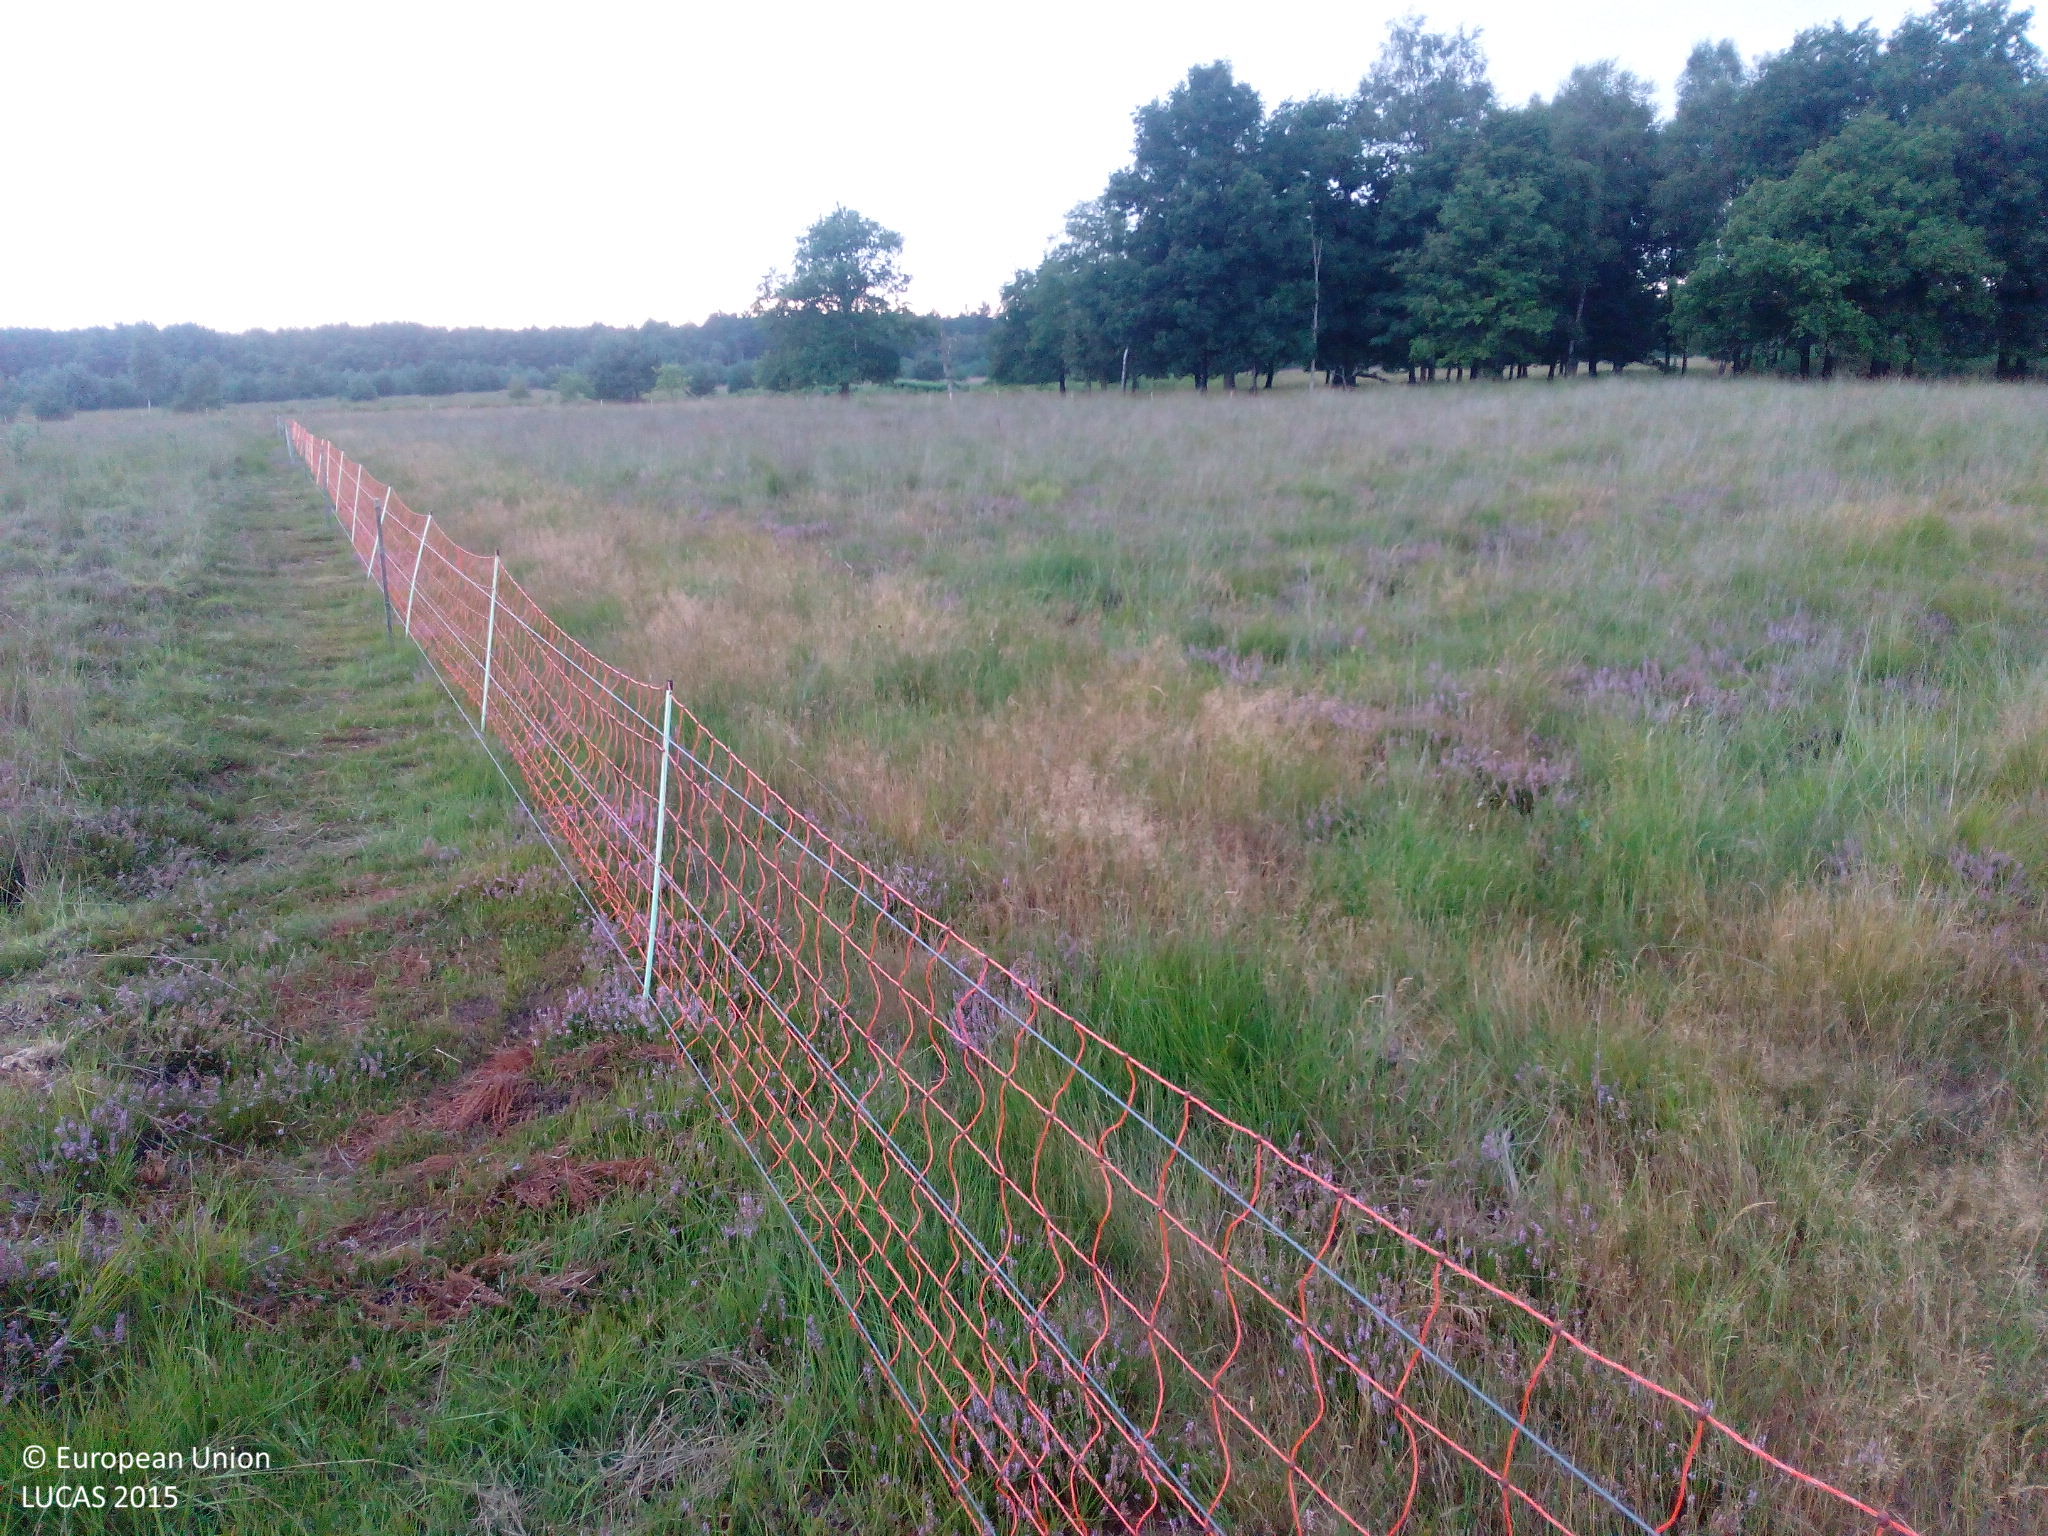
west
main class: Shrubland
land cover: Shrubland without tree cover
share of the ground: 10 - 25 %
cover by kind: herbaceous plants 85 %, shrubs 15 %
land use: Community services
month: August
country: NL
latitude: 51.2170
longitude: 5.6318
